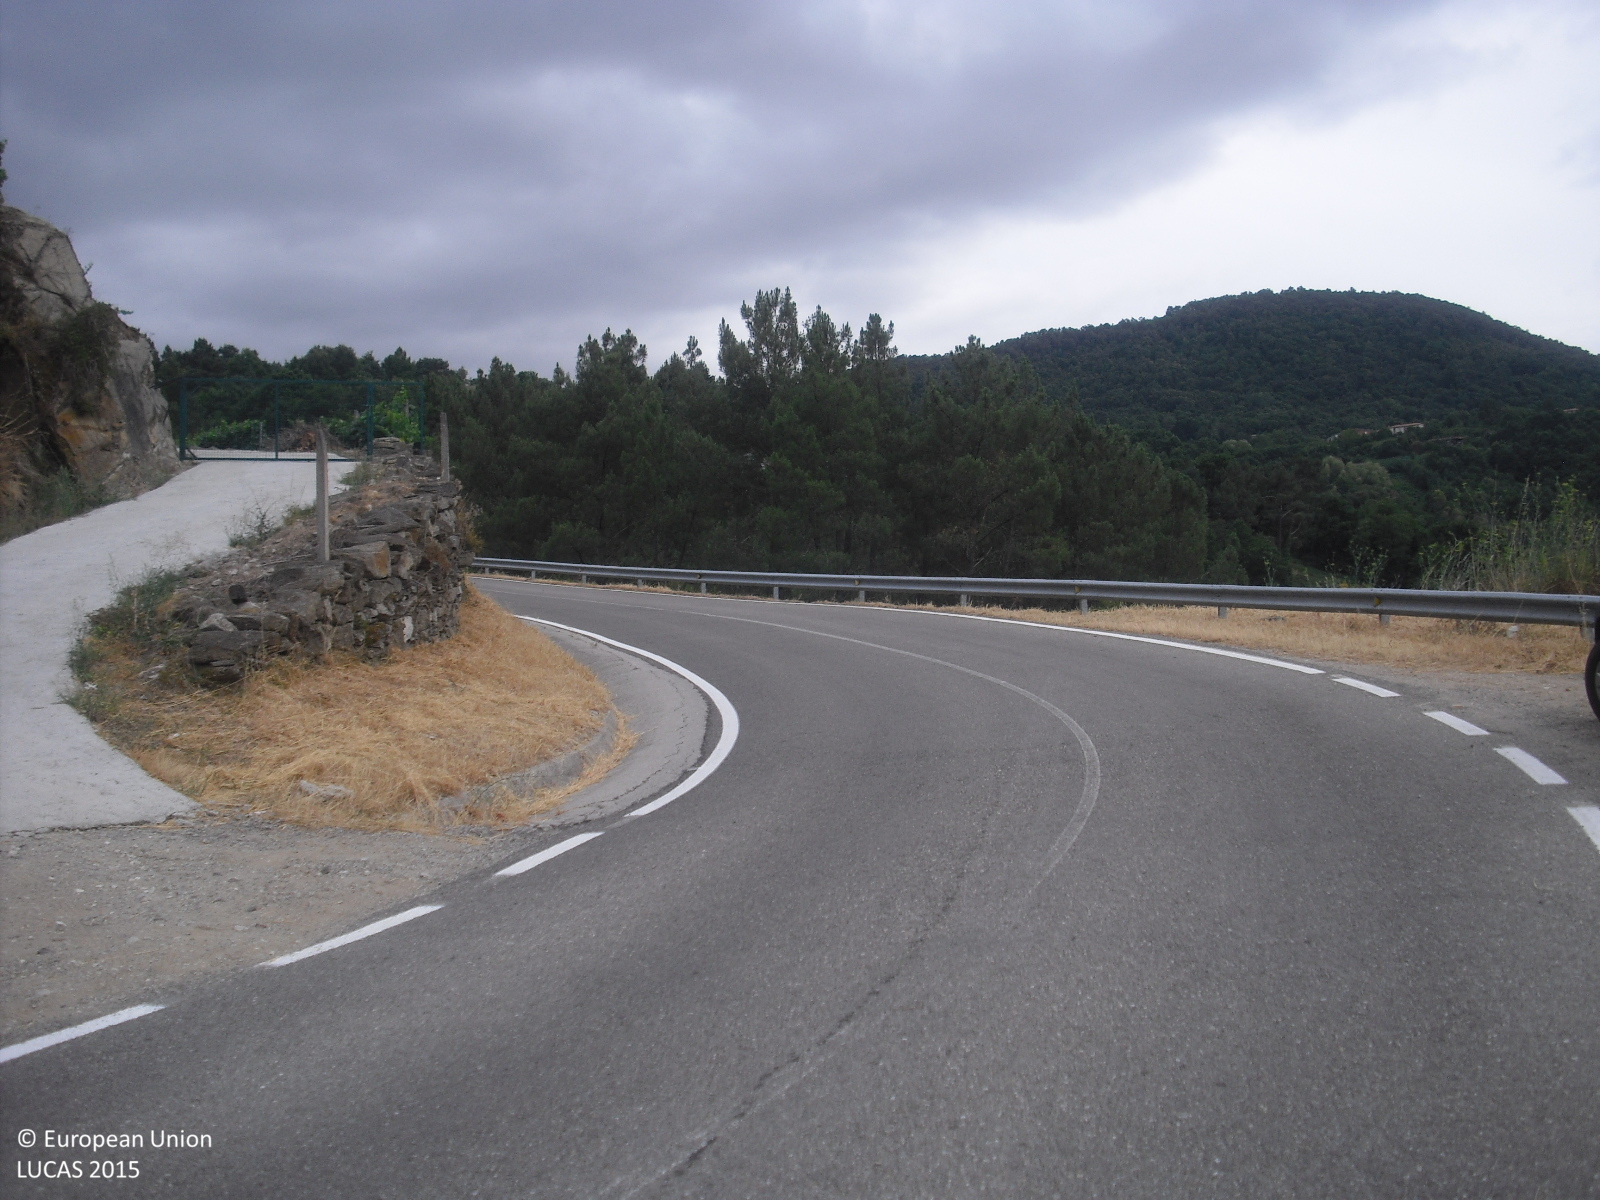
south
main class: Woodland
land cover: Broadleaved woodland
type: thermophilous deciduous forest
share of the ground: > 75 %
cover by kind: broadleaved forest trees 70 %, shrubs 30 %
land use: Semi-natural and natural areas not in use
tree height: > 5 m
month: July
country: ES
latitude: 42.3970
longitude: -7.4511
